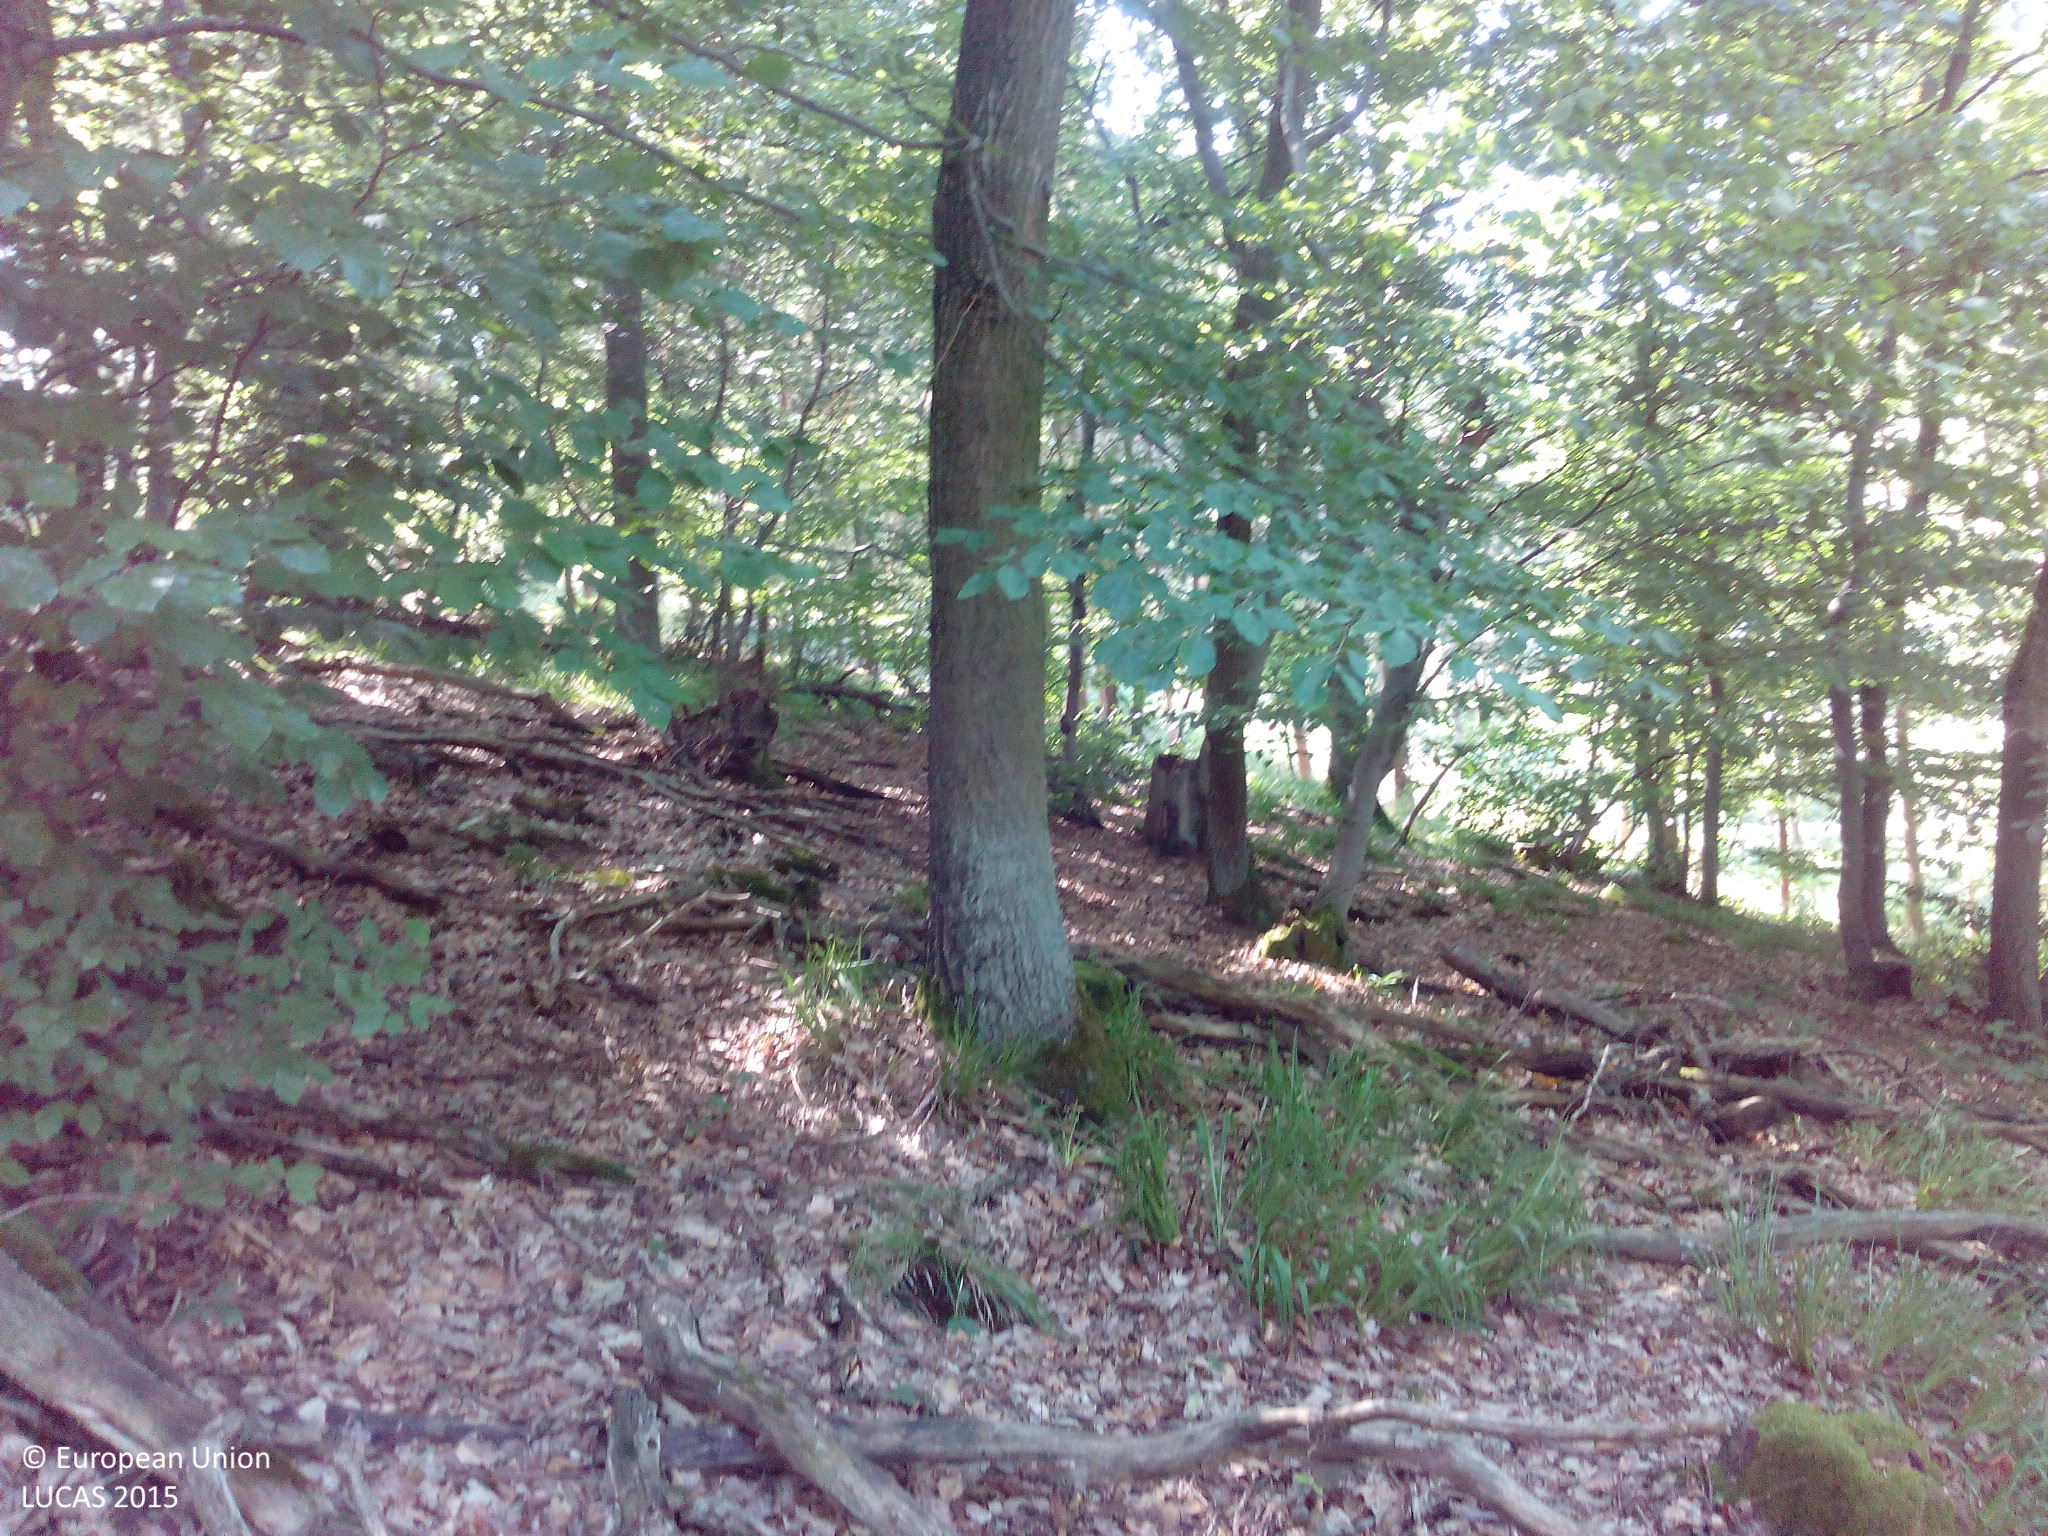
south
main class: Woodland
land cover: Broadleaved woodland
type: mesophytic deciduous forest
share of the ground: > 75 %
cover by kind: broadleaved forest trees 80 %, unconsolidated bare surface 10 %, herbaceous plants 5 %, lichens and mosses 5 %
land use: Forestry
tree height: > 5 m
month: August
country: DE
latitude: 50.2639
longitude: 7.4611
